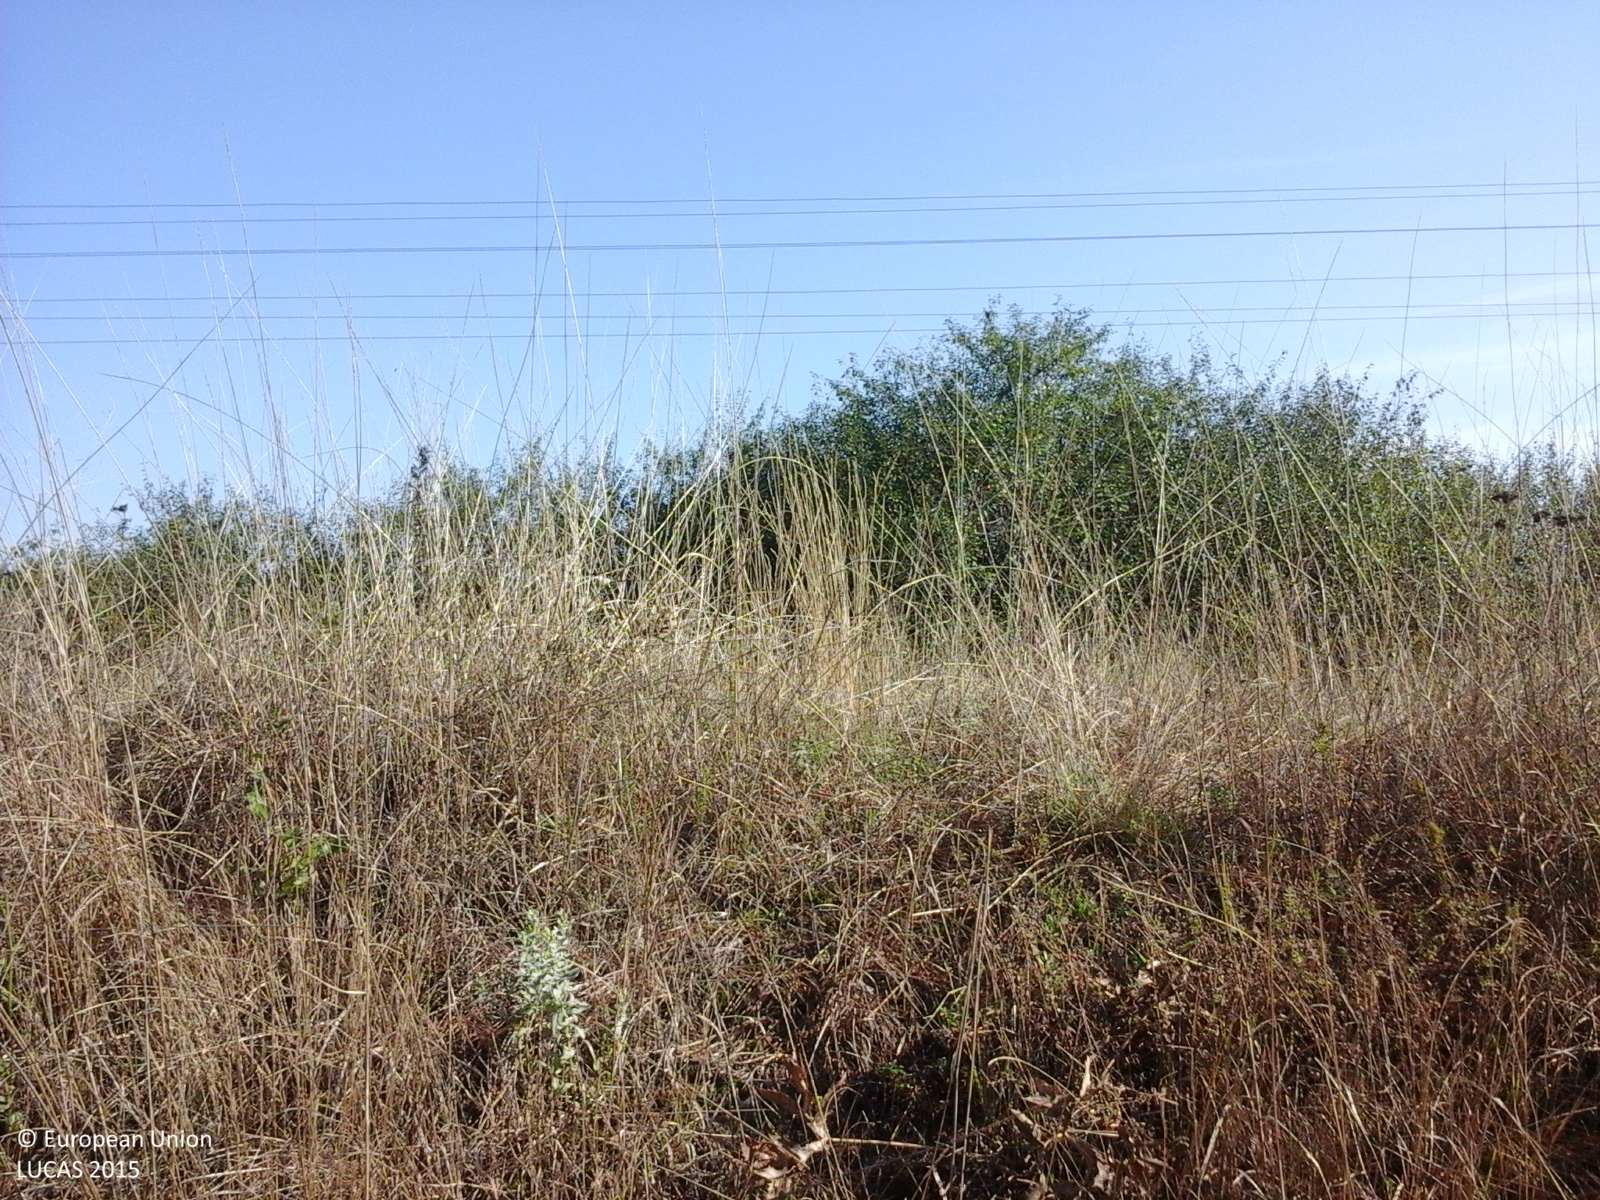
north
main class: Grassland
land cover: Spontaneously vegetated surfaces
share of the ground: > 75 %
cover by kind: herbaceous plants 100 %
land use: Semi-natural and natural areas not in use
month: August
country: RO
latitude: 45.6965
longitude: 21.2938
